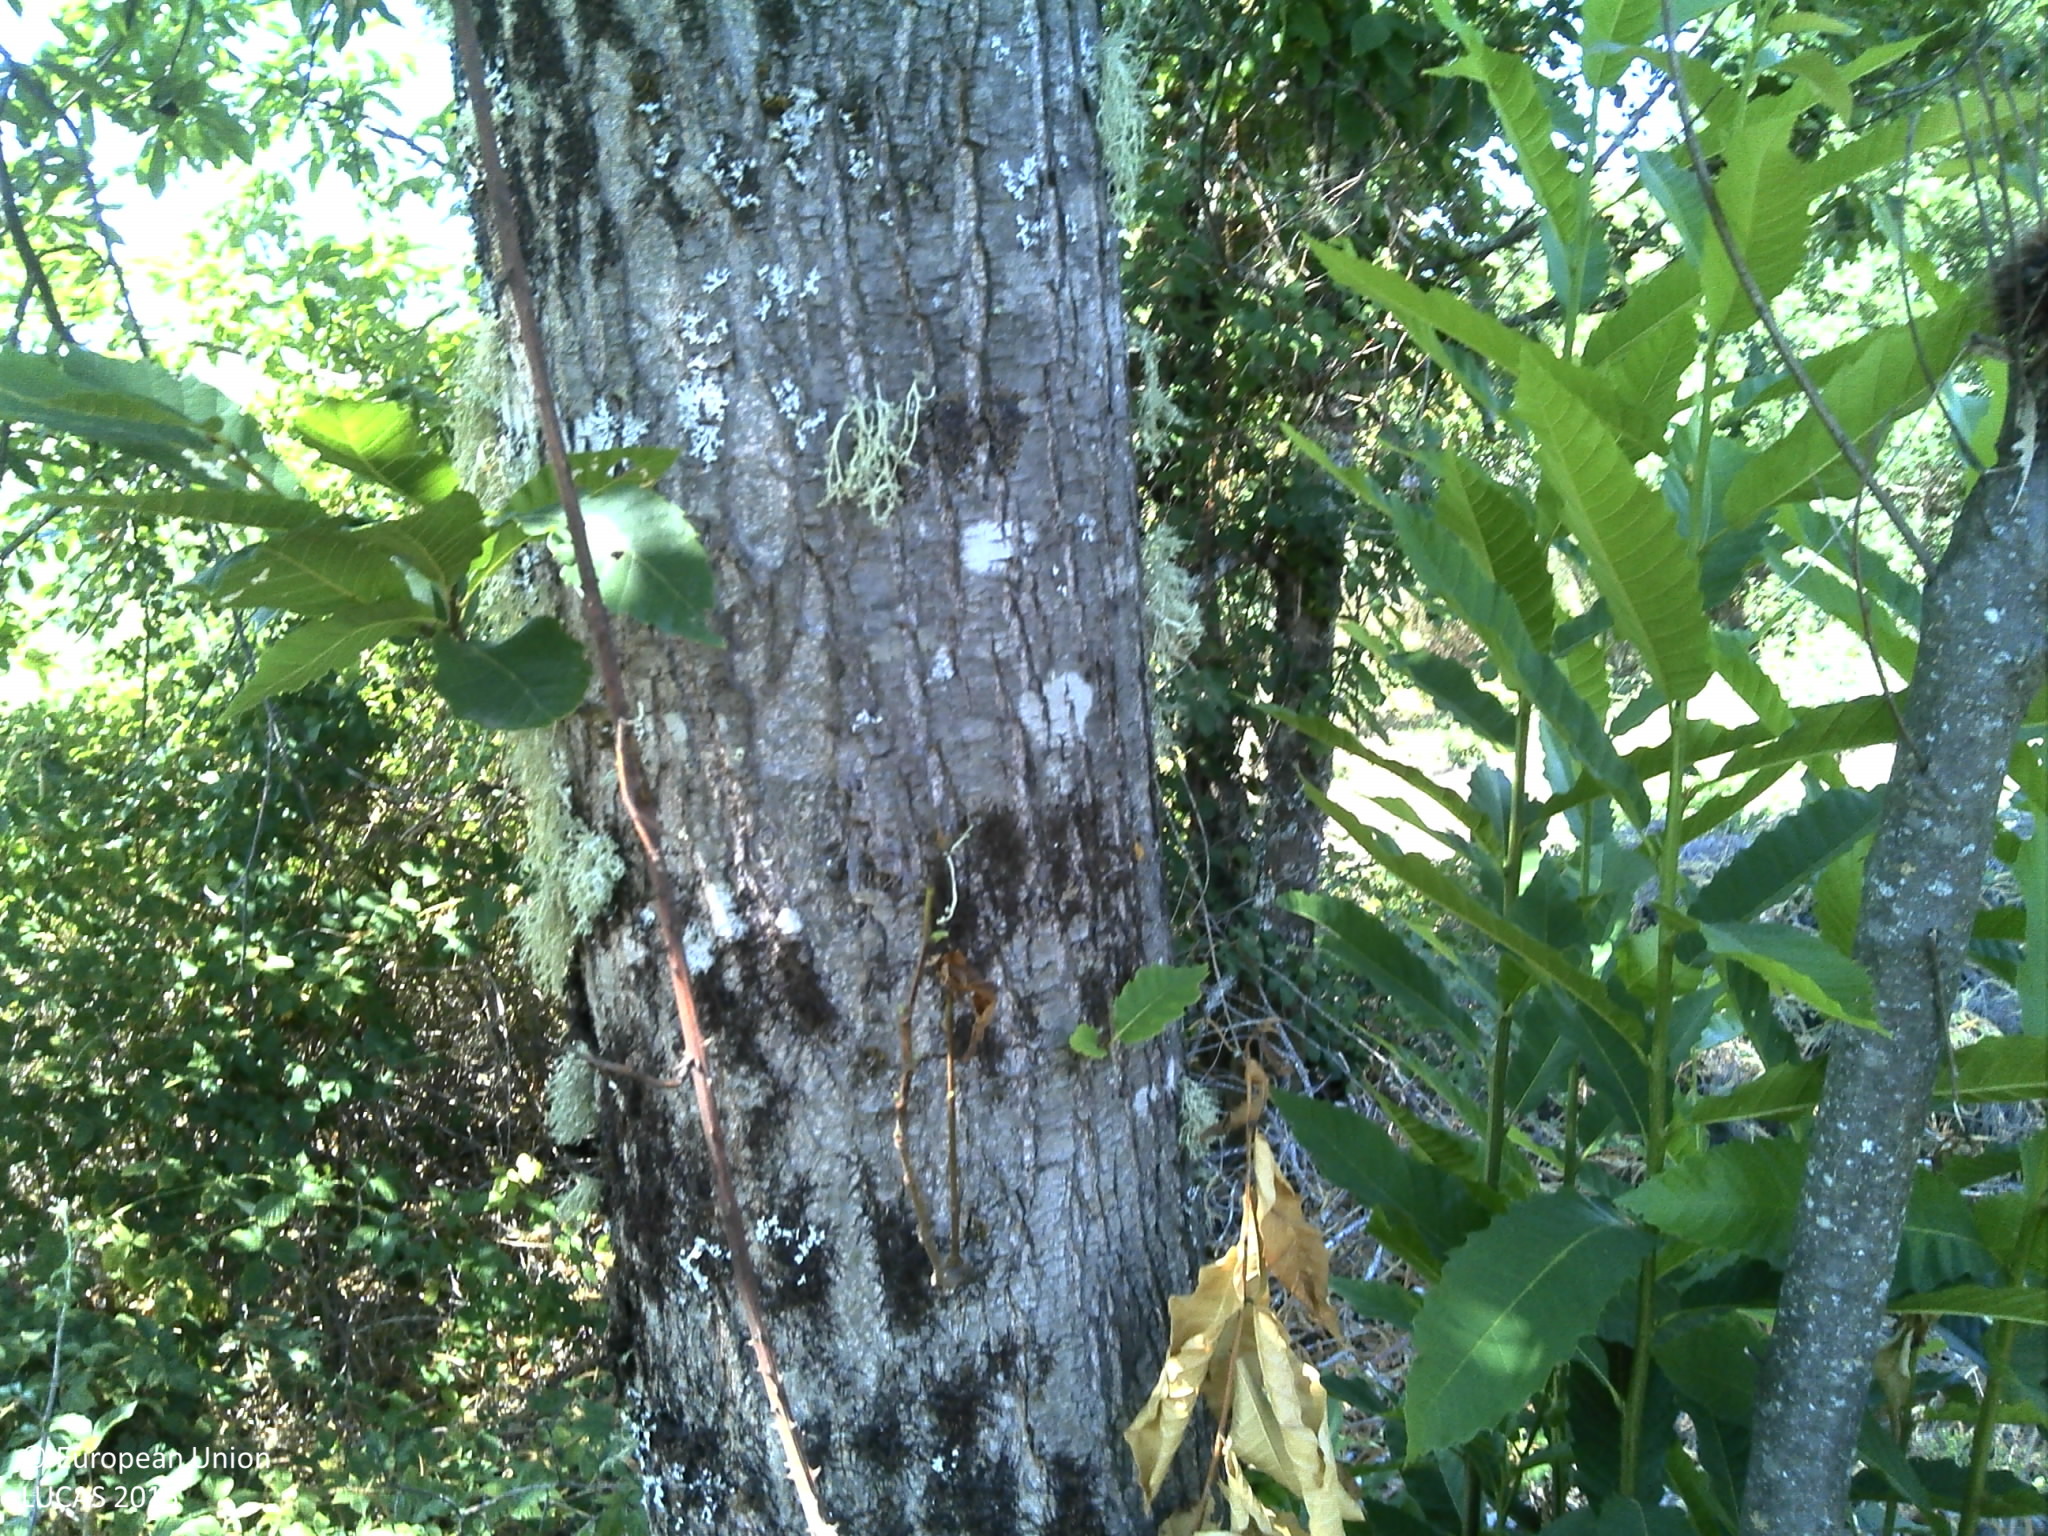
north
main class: Cropland
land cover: Nuts trees
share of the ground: < 10 %
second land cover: Shrubland without tree cover
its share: 25 - 50 %
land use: Agriculture (excluding fallow land and kitchen gardens)
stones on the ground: 25 - 50 %
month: July
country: PT
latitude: 40.8589
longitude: -7.4965
